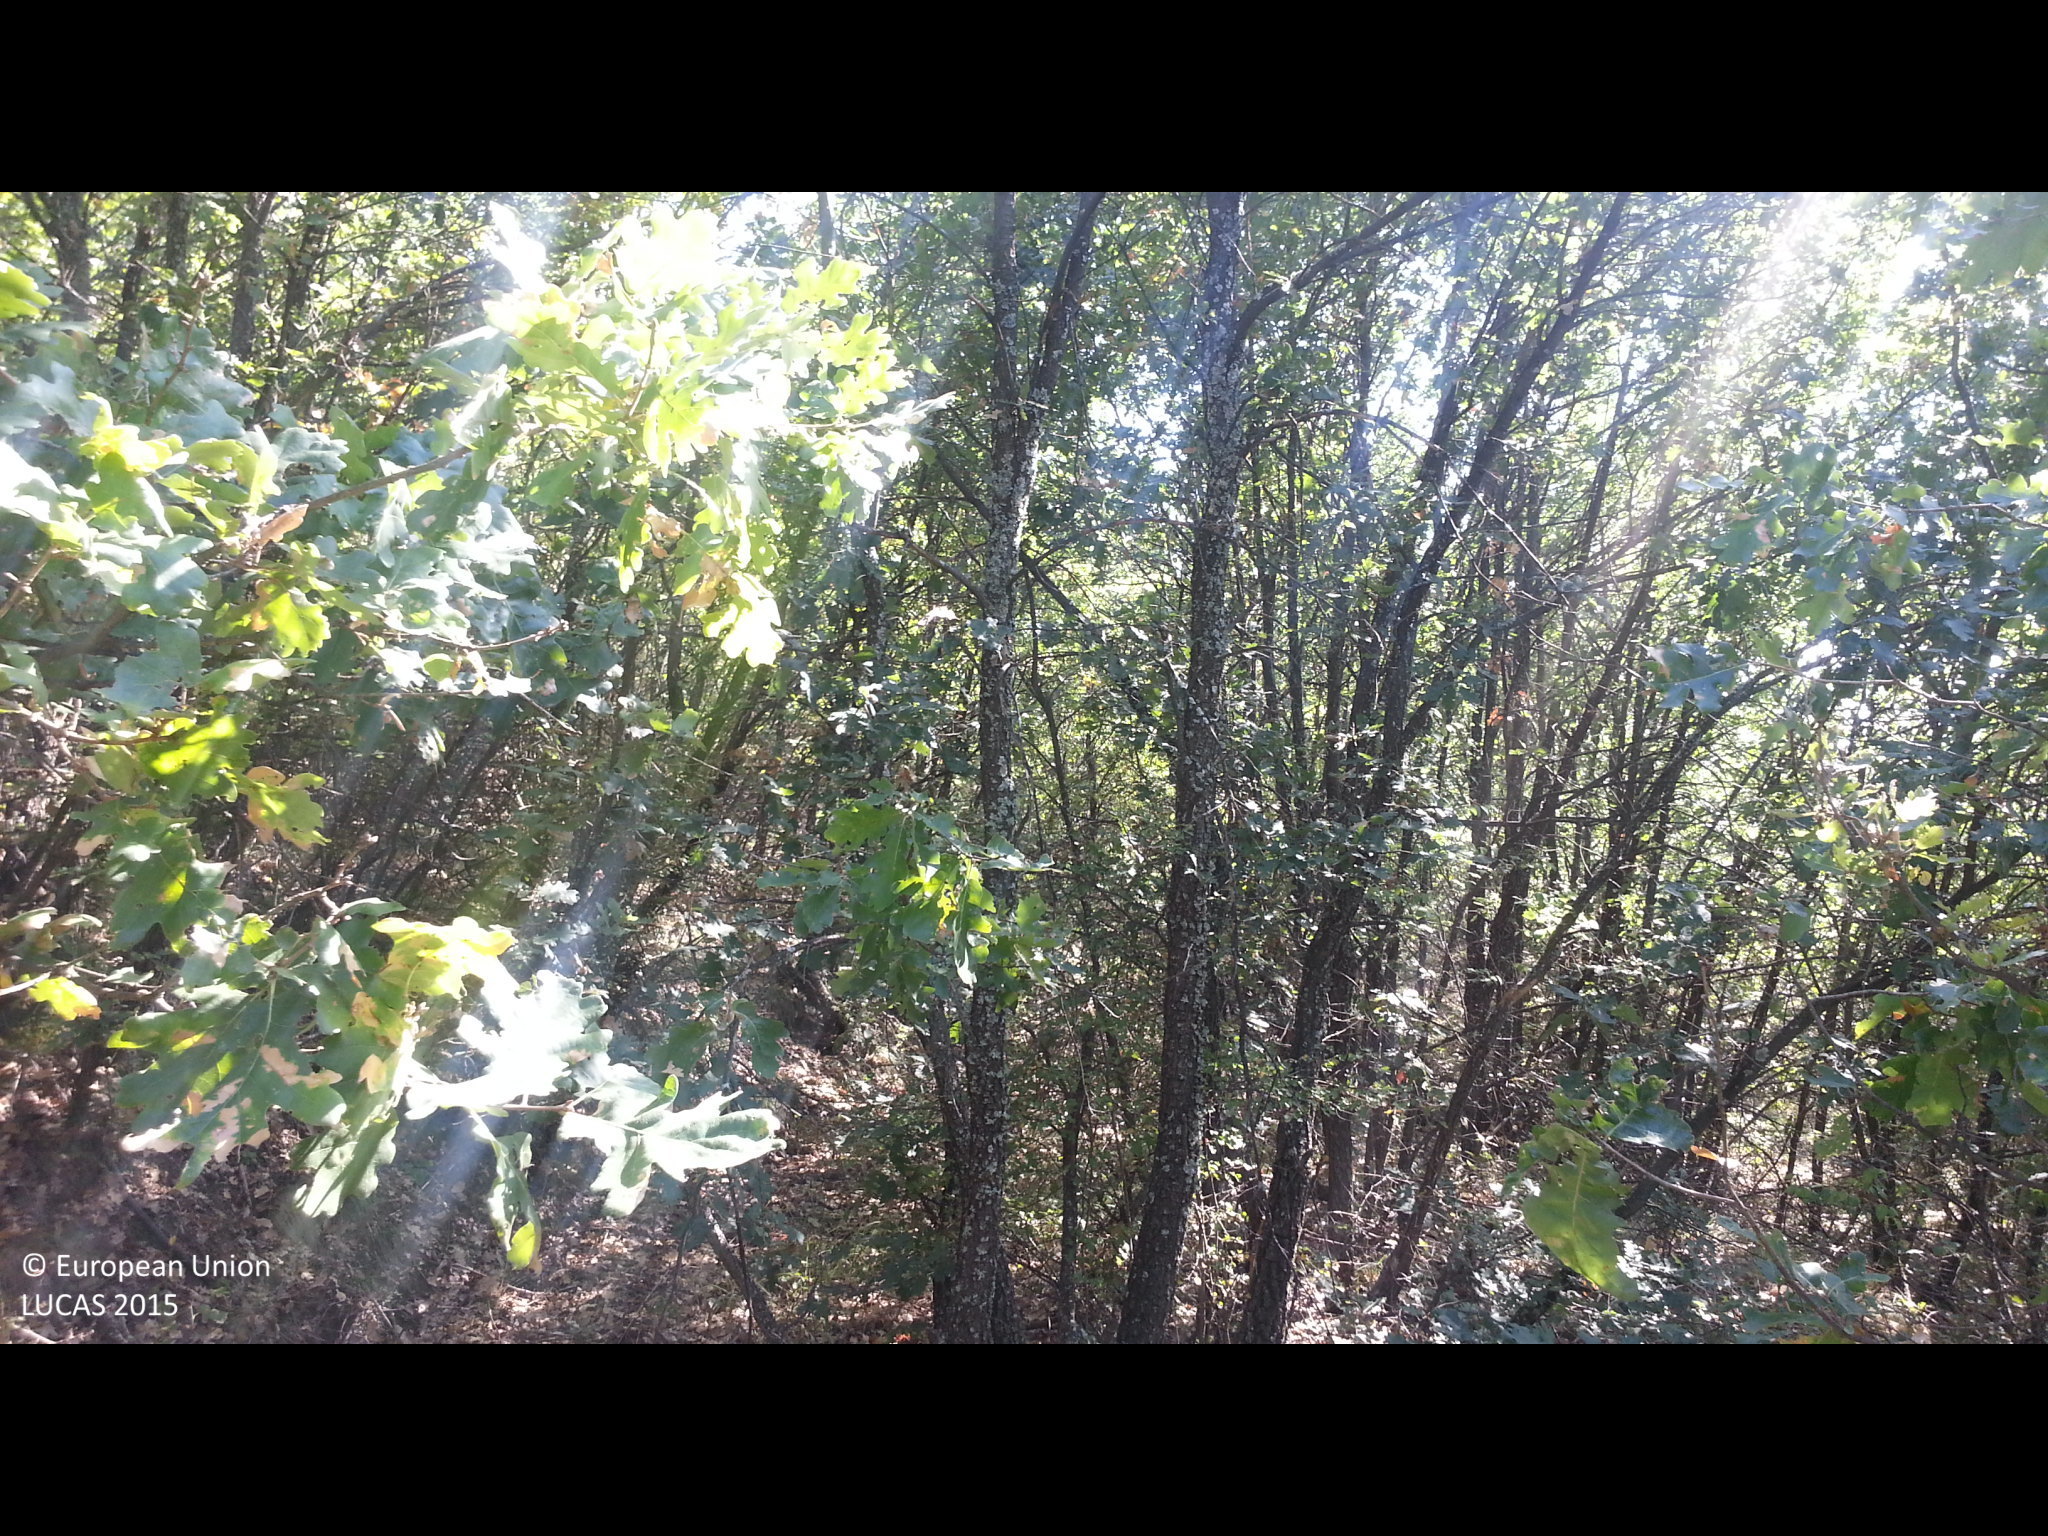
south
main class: Woodland
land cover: Broadleaved woodland
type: thermophilous deciduous forest
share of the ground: > 75 %
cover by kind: broadleaved forest trees 95 %, shrubs 5 %
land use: Forestry
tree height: > 5 m
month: September
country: BG
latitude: 42.1340
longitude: 23.0547
